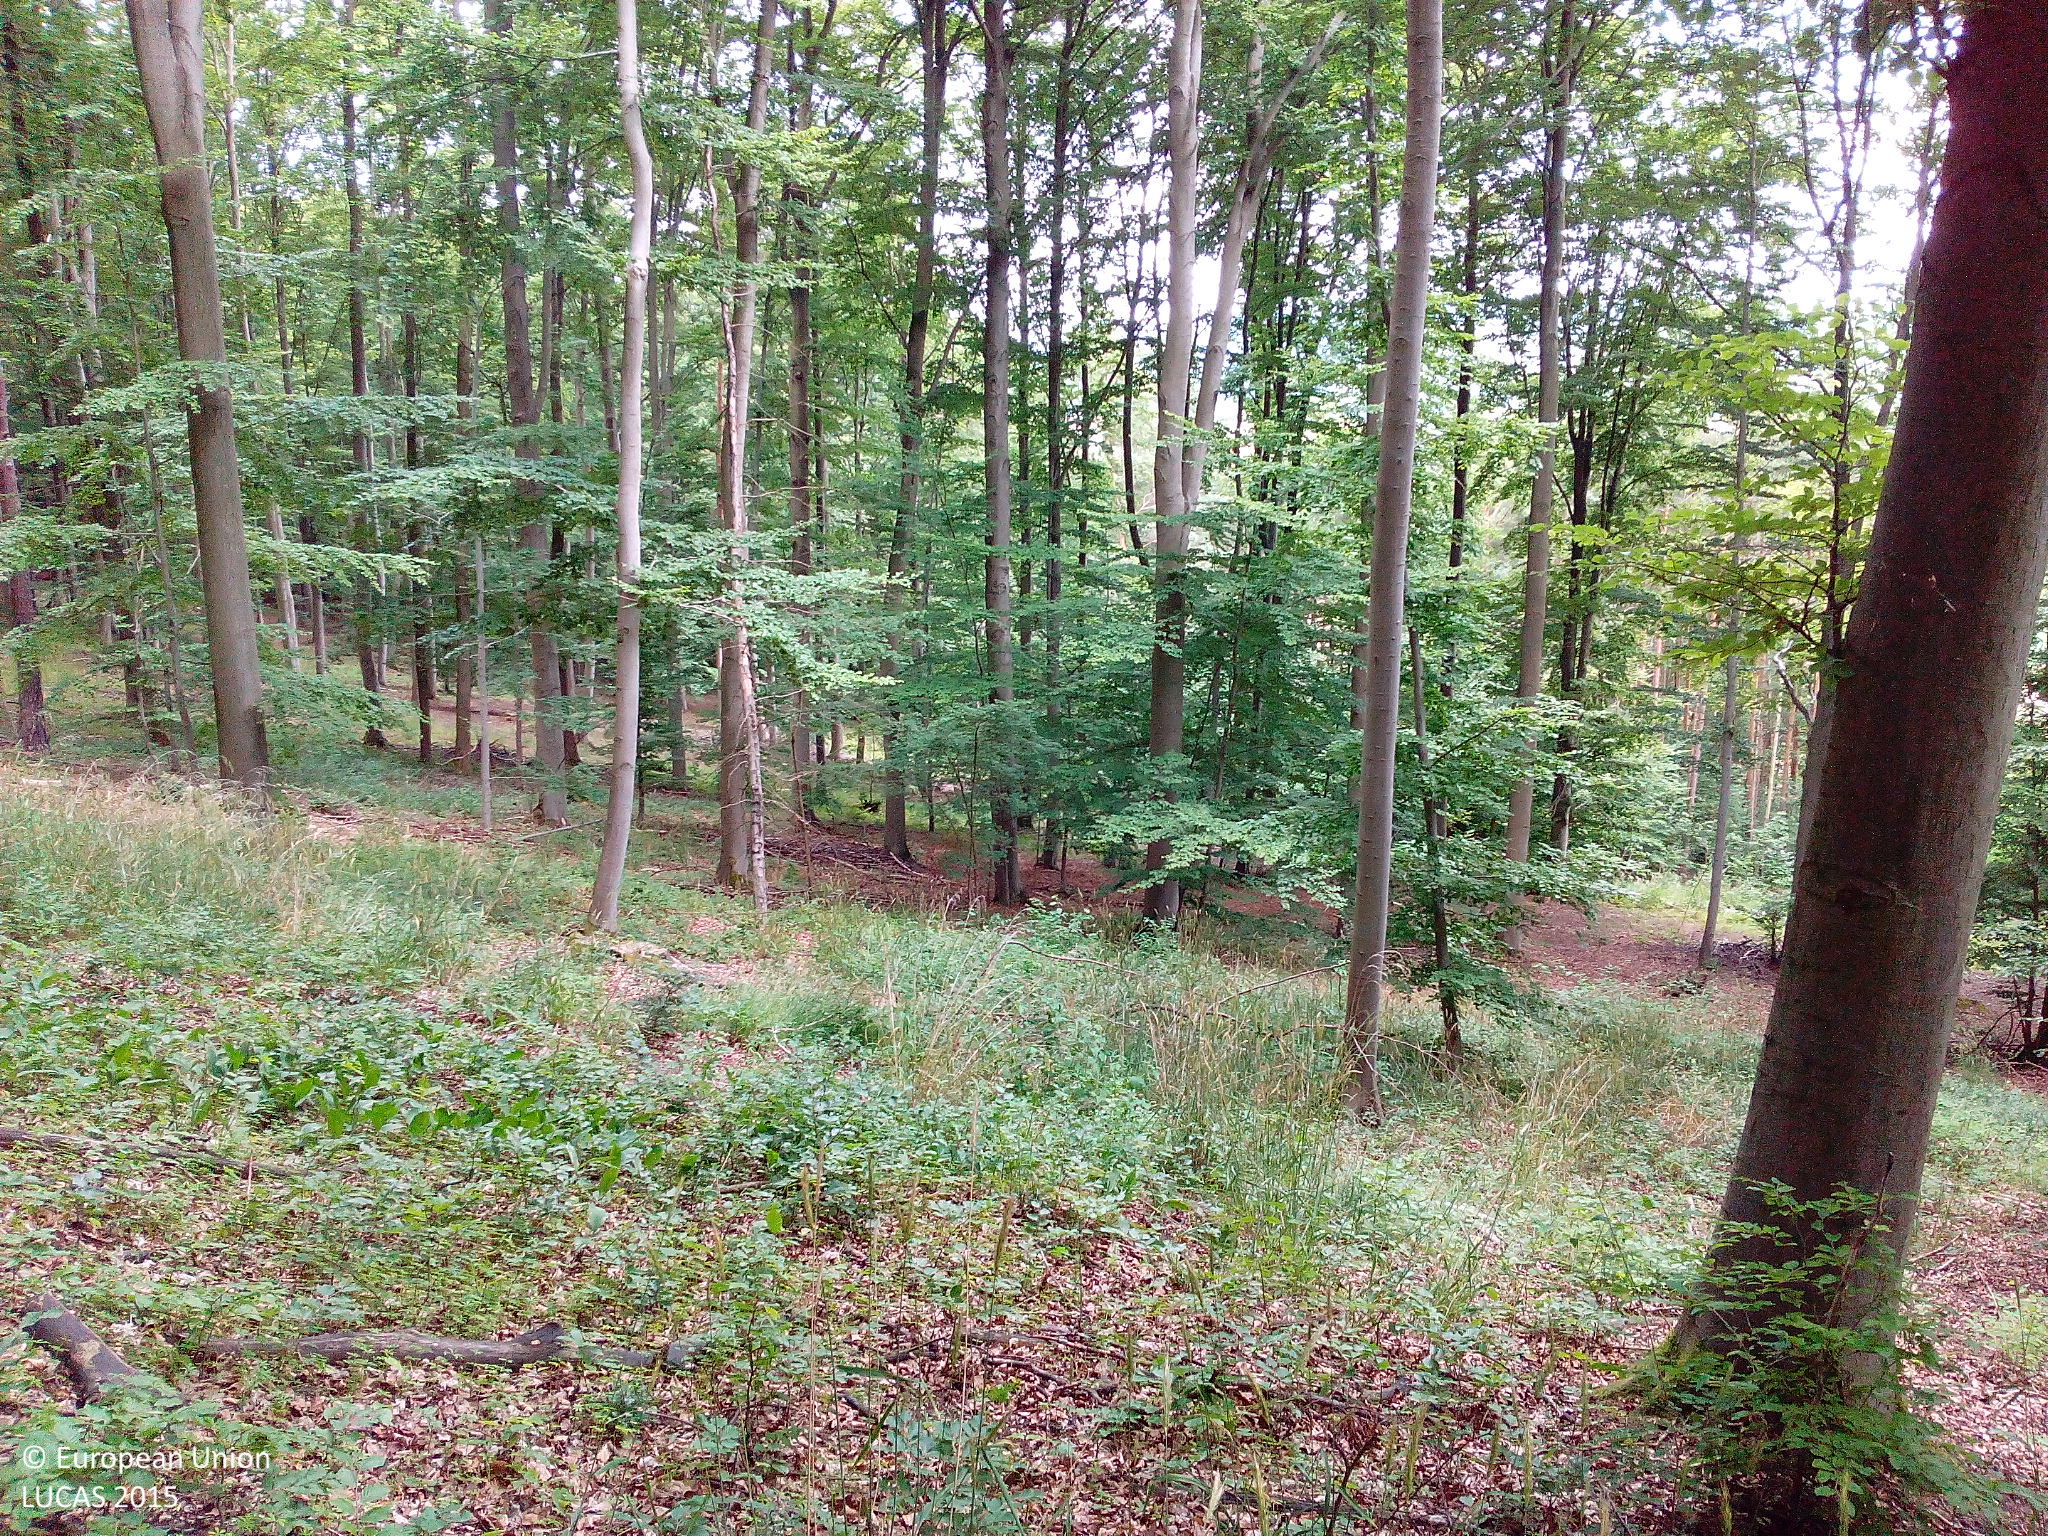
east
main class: Woodland
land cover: Broadleaved woodland
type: beech forest
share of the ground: > 75 %
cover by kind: broadleaved forest trees 90 %, herbaceous plants 5 %, unconsolidated bare surface 5 %
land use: Forestry
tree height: > 5 m
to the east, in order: Broadleaved woodland; Pine dominated mixed woodland; Fences; Grassland without tree/shrub cover
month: July
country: DE
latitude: 50.7416
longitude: 9.9008
